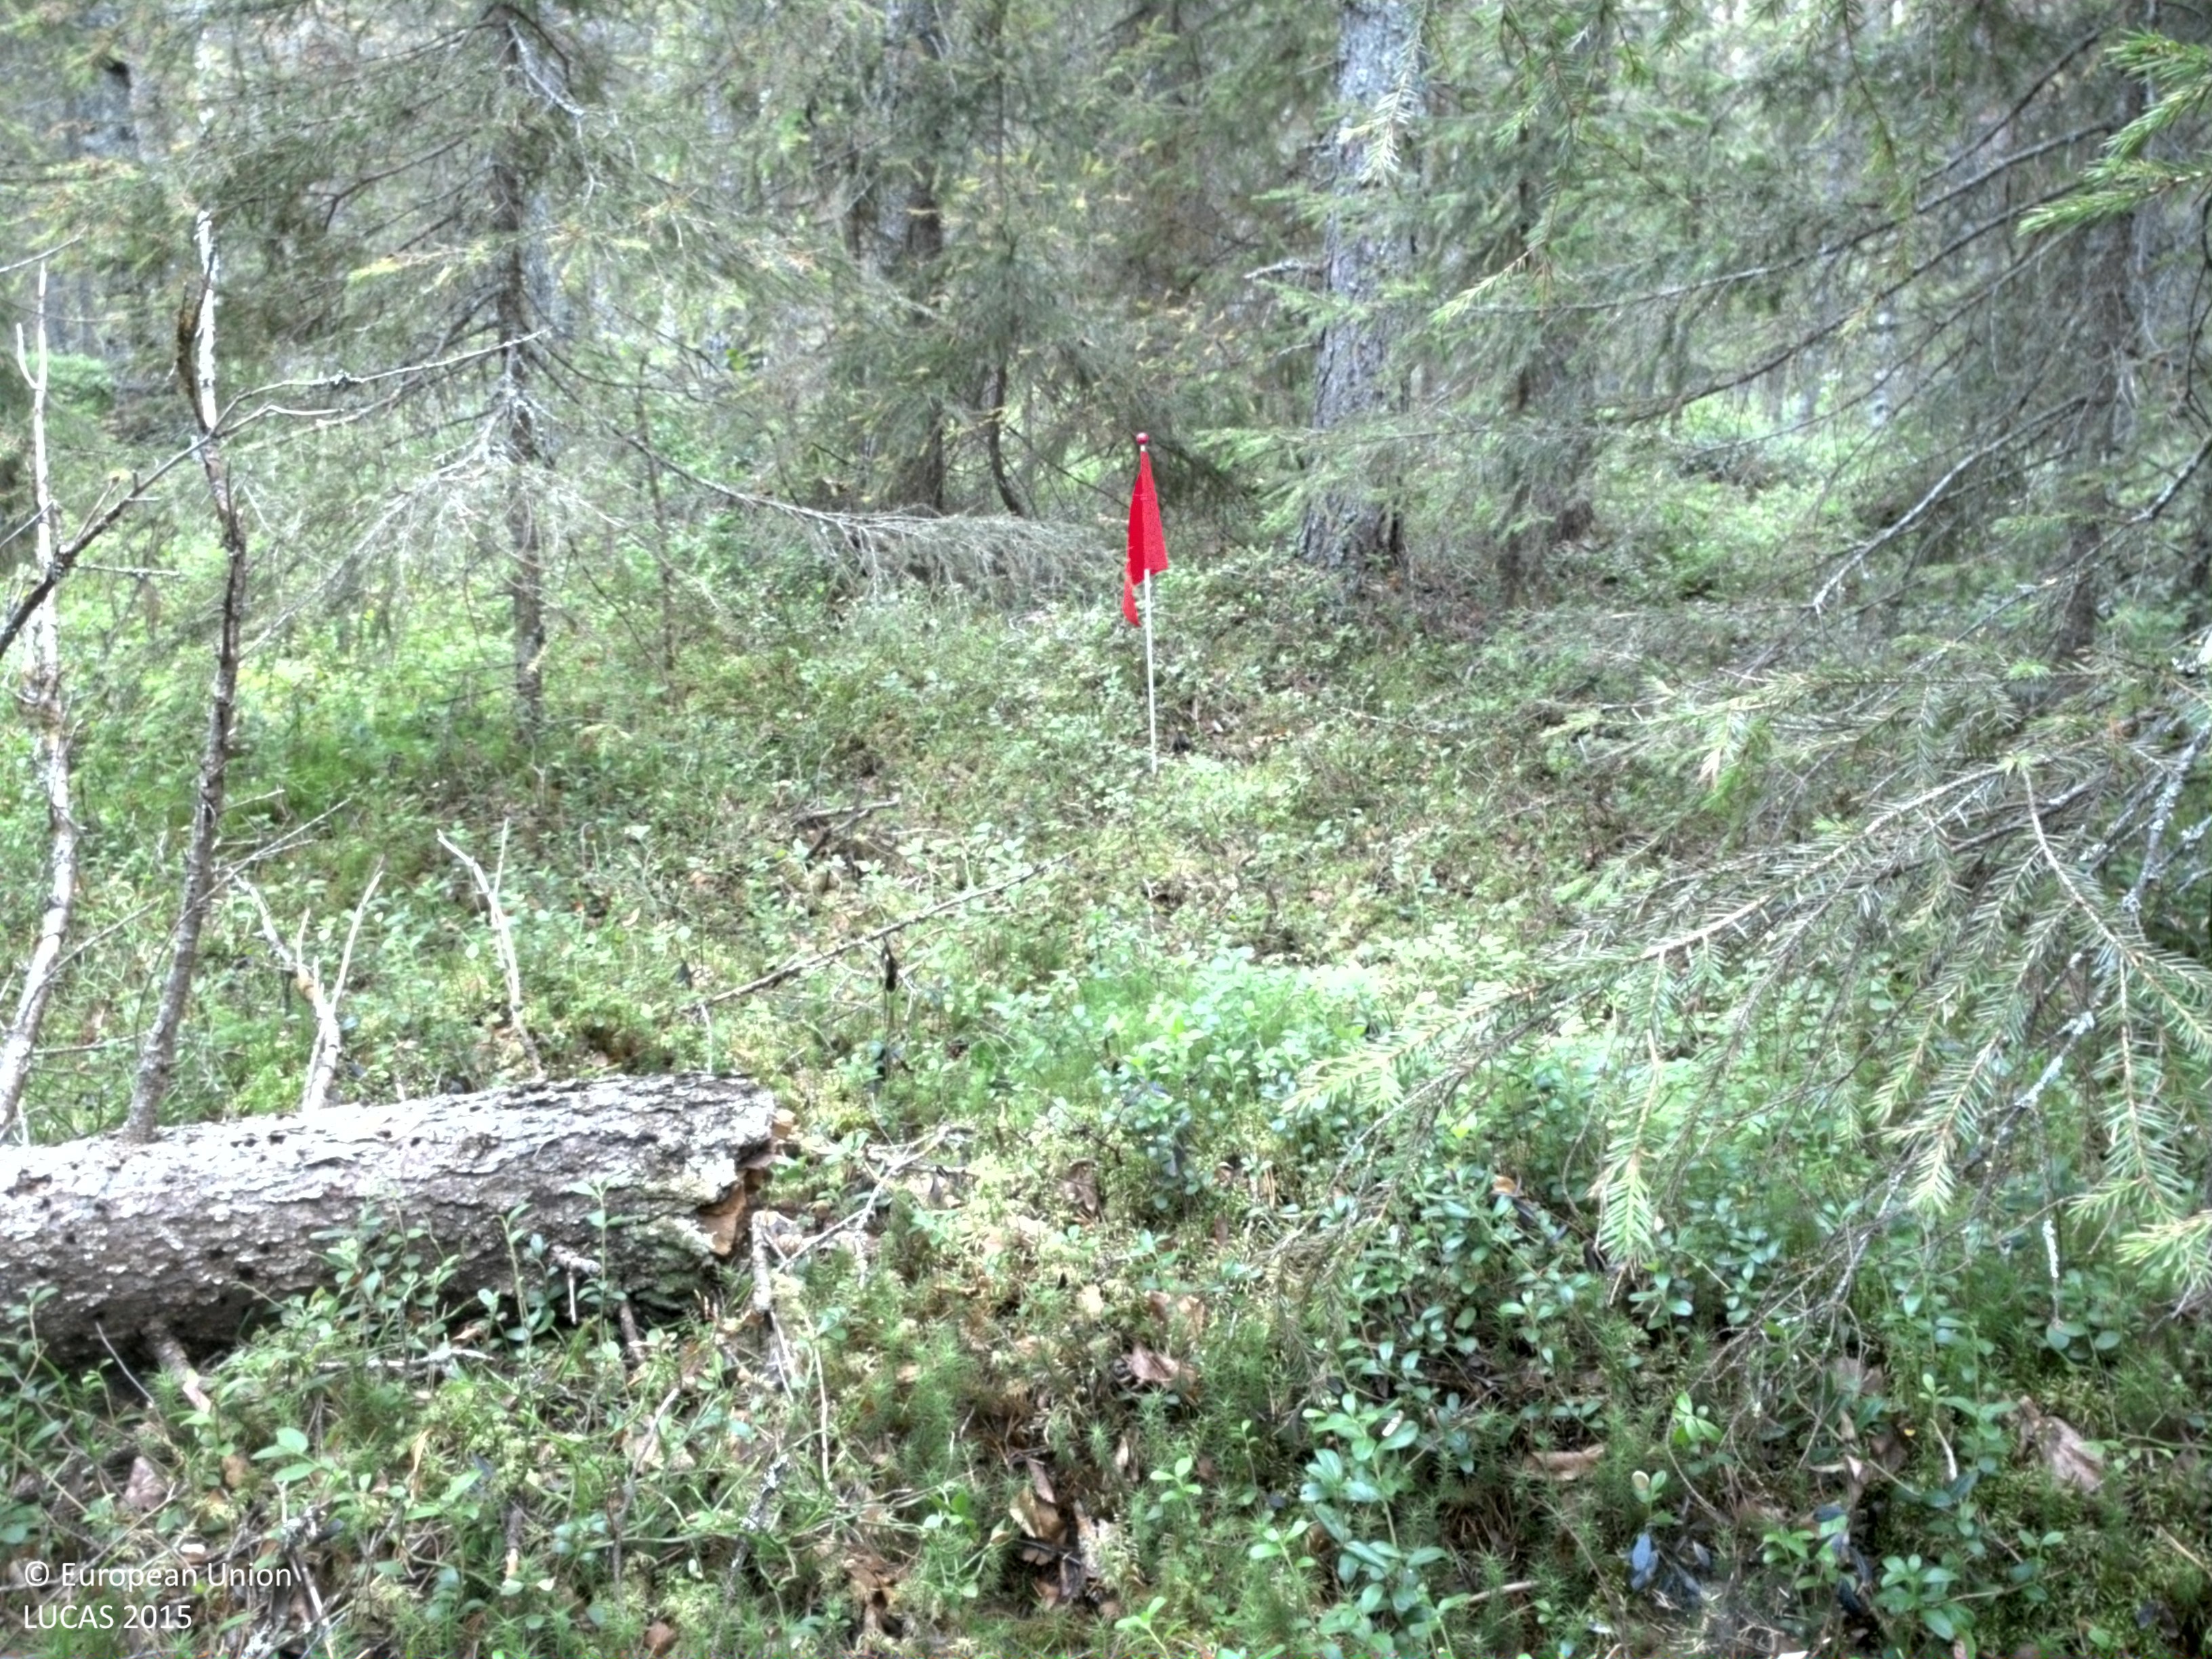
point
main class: Woodland
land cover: Other coniferous woodland
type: boreal forest
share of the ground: 25 - 50 %
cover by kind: shrubs 60 %, coniferous forest trees 40 %
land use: Forestry
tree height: > 5 m
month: August
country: SE
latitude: 66.2100
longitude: 22.7976
